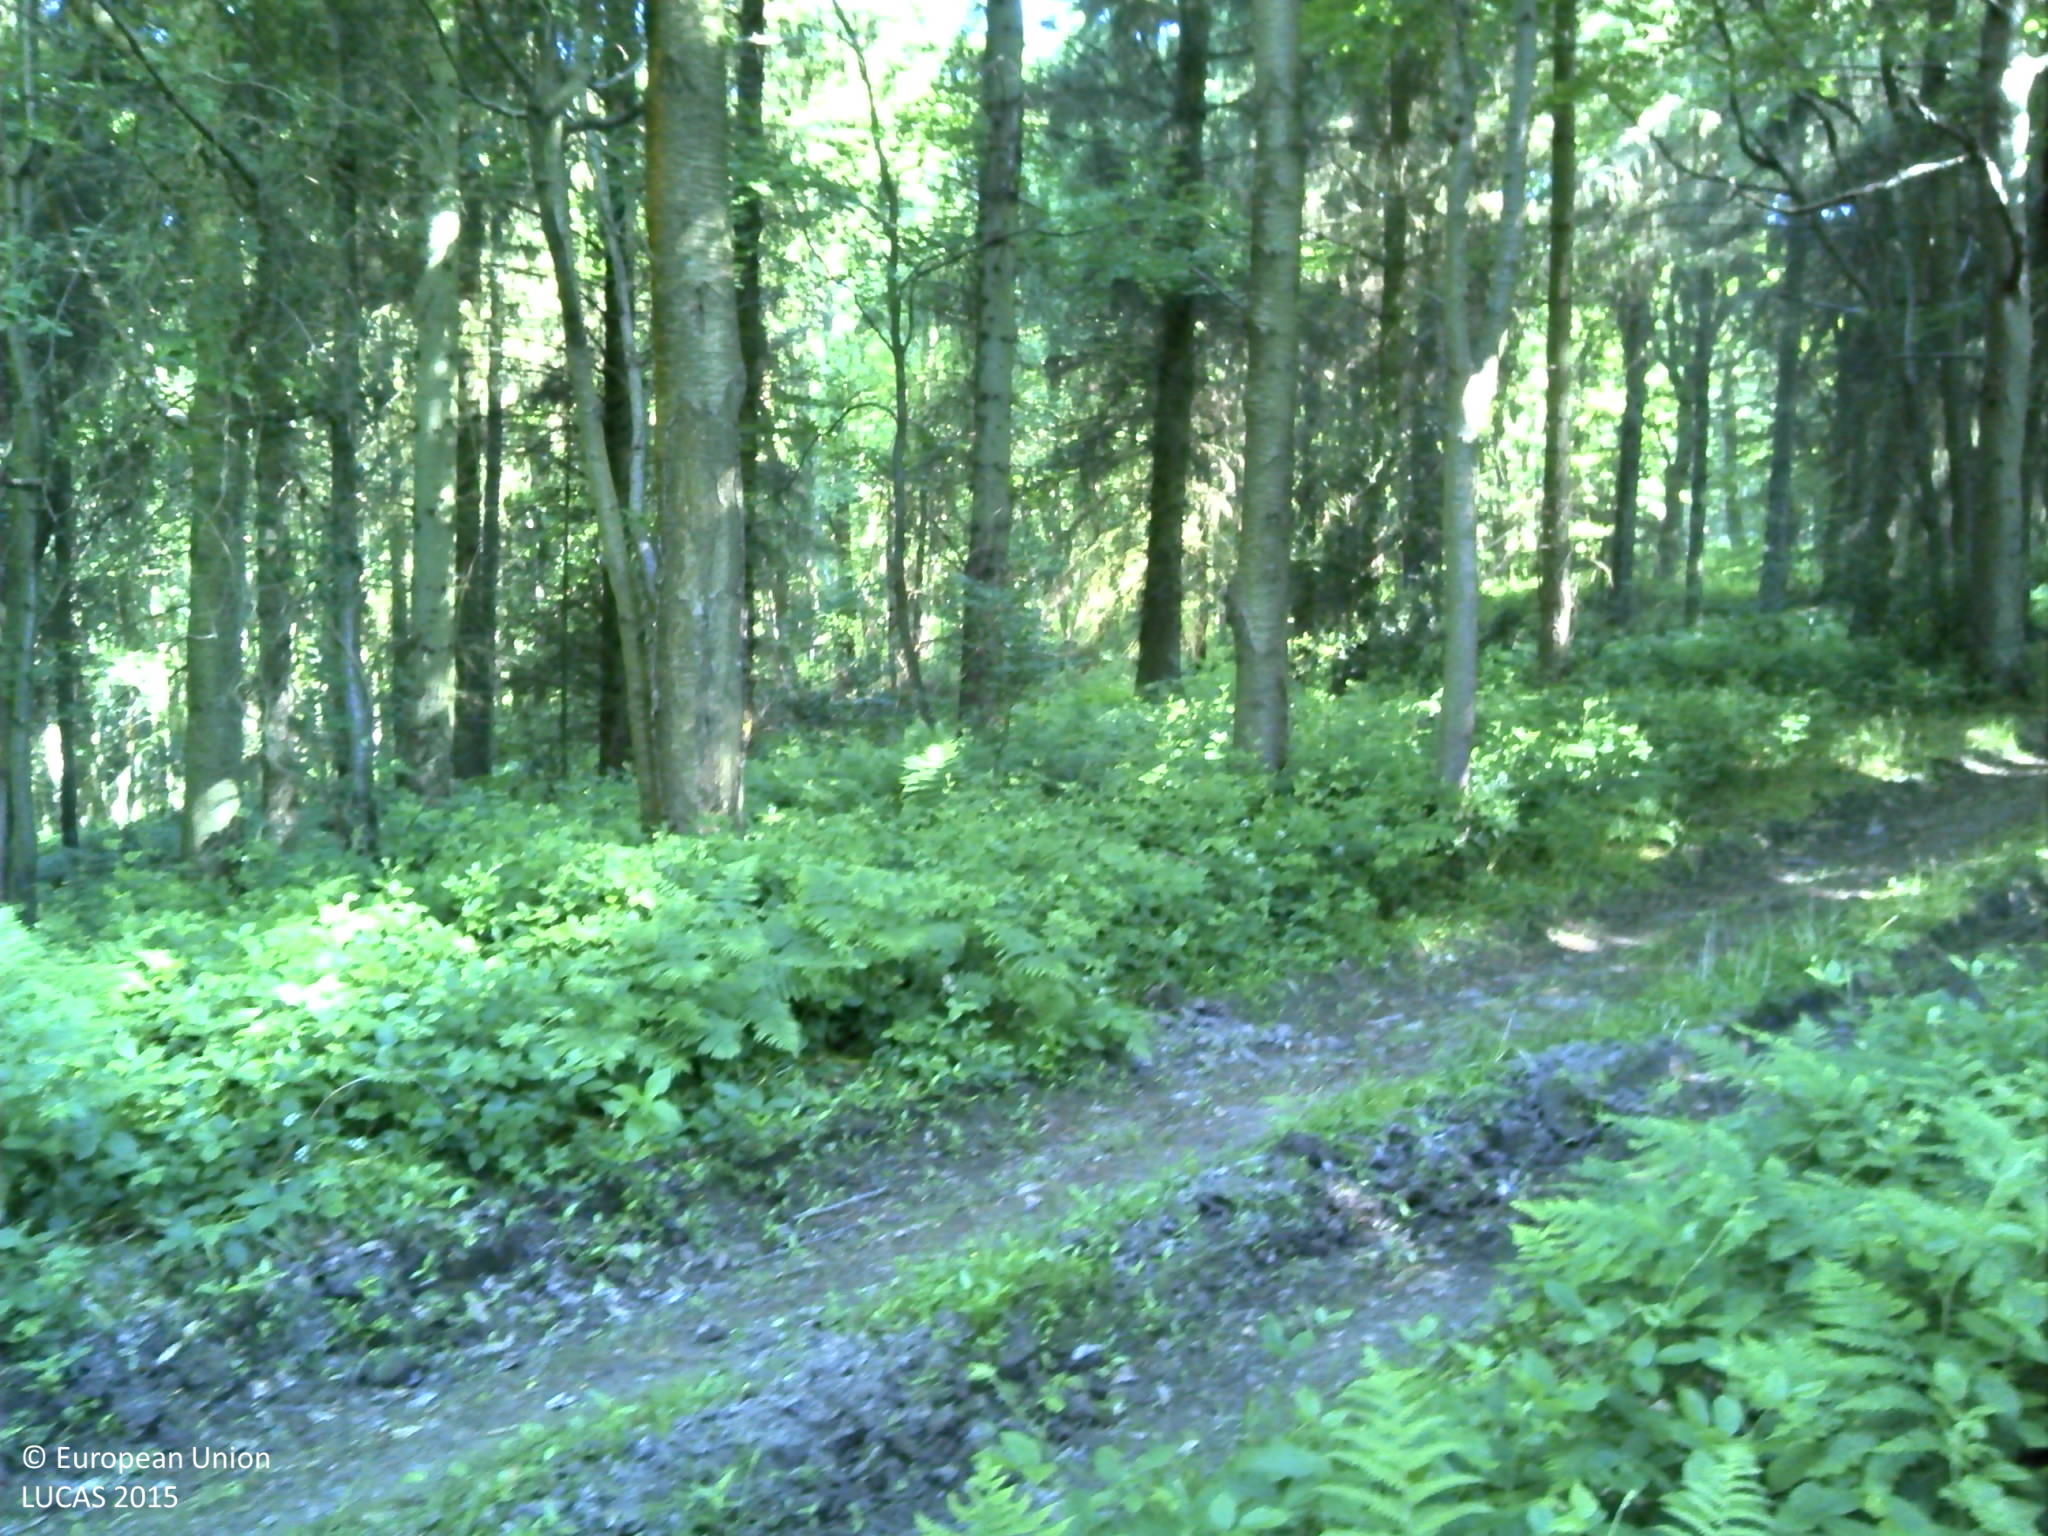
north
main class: Woodland
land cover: Spruce dominated mixed woodland
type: beech forest
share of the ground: > 75 %
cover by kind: coniferous forest trees 45 %, broadleaved forest trees 45 %, herbaceous plants 10 %
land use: Forestry
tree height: > 5 m
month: June
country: FR
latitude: 49.5633
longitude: 1.0883
